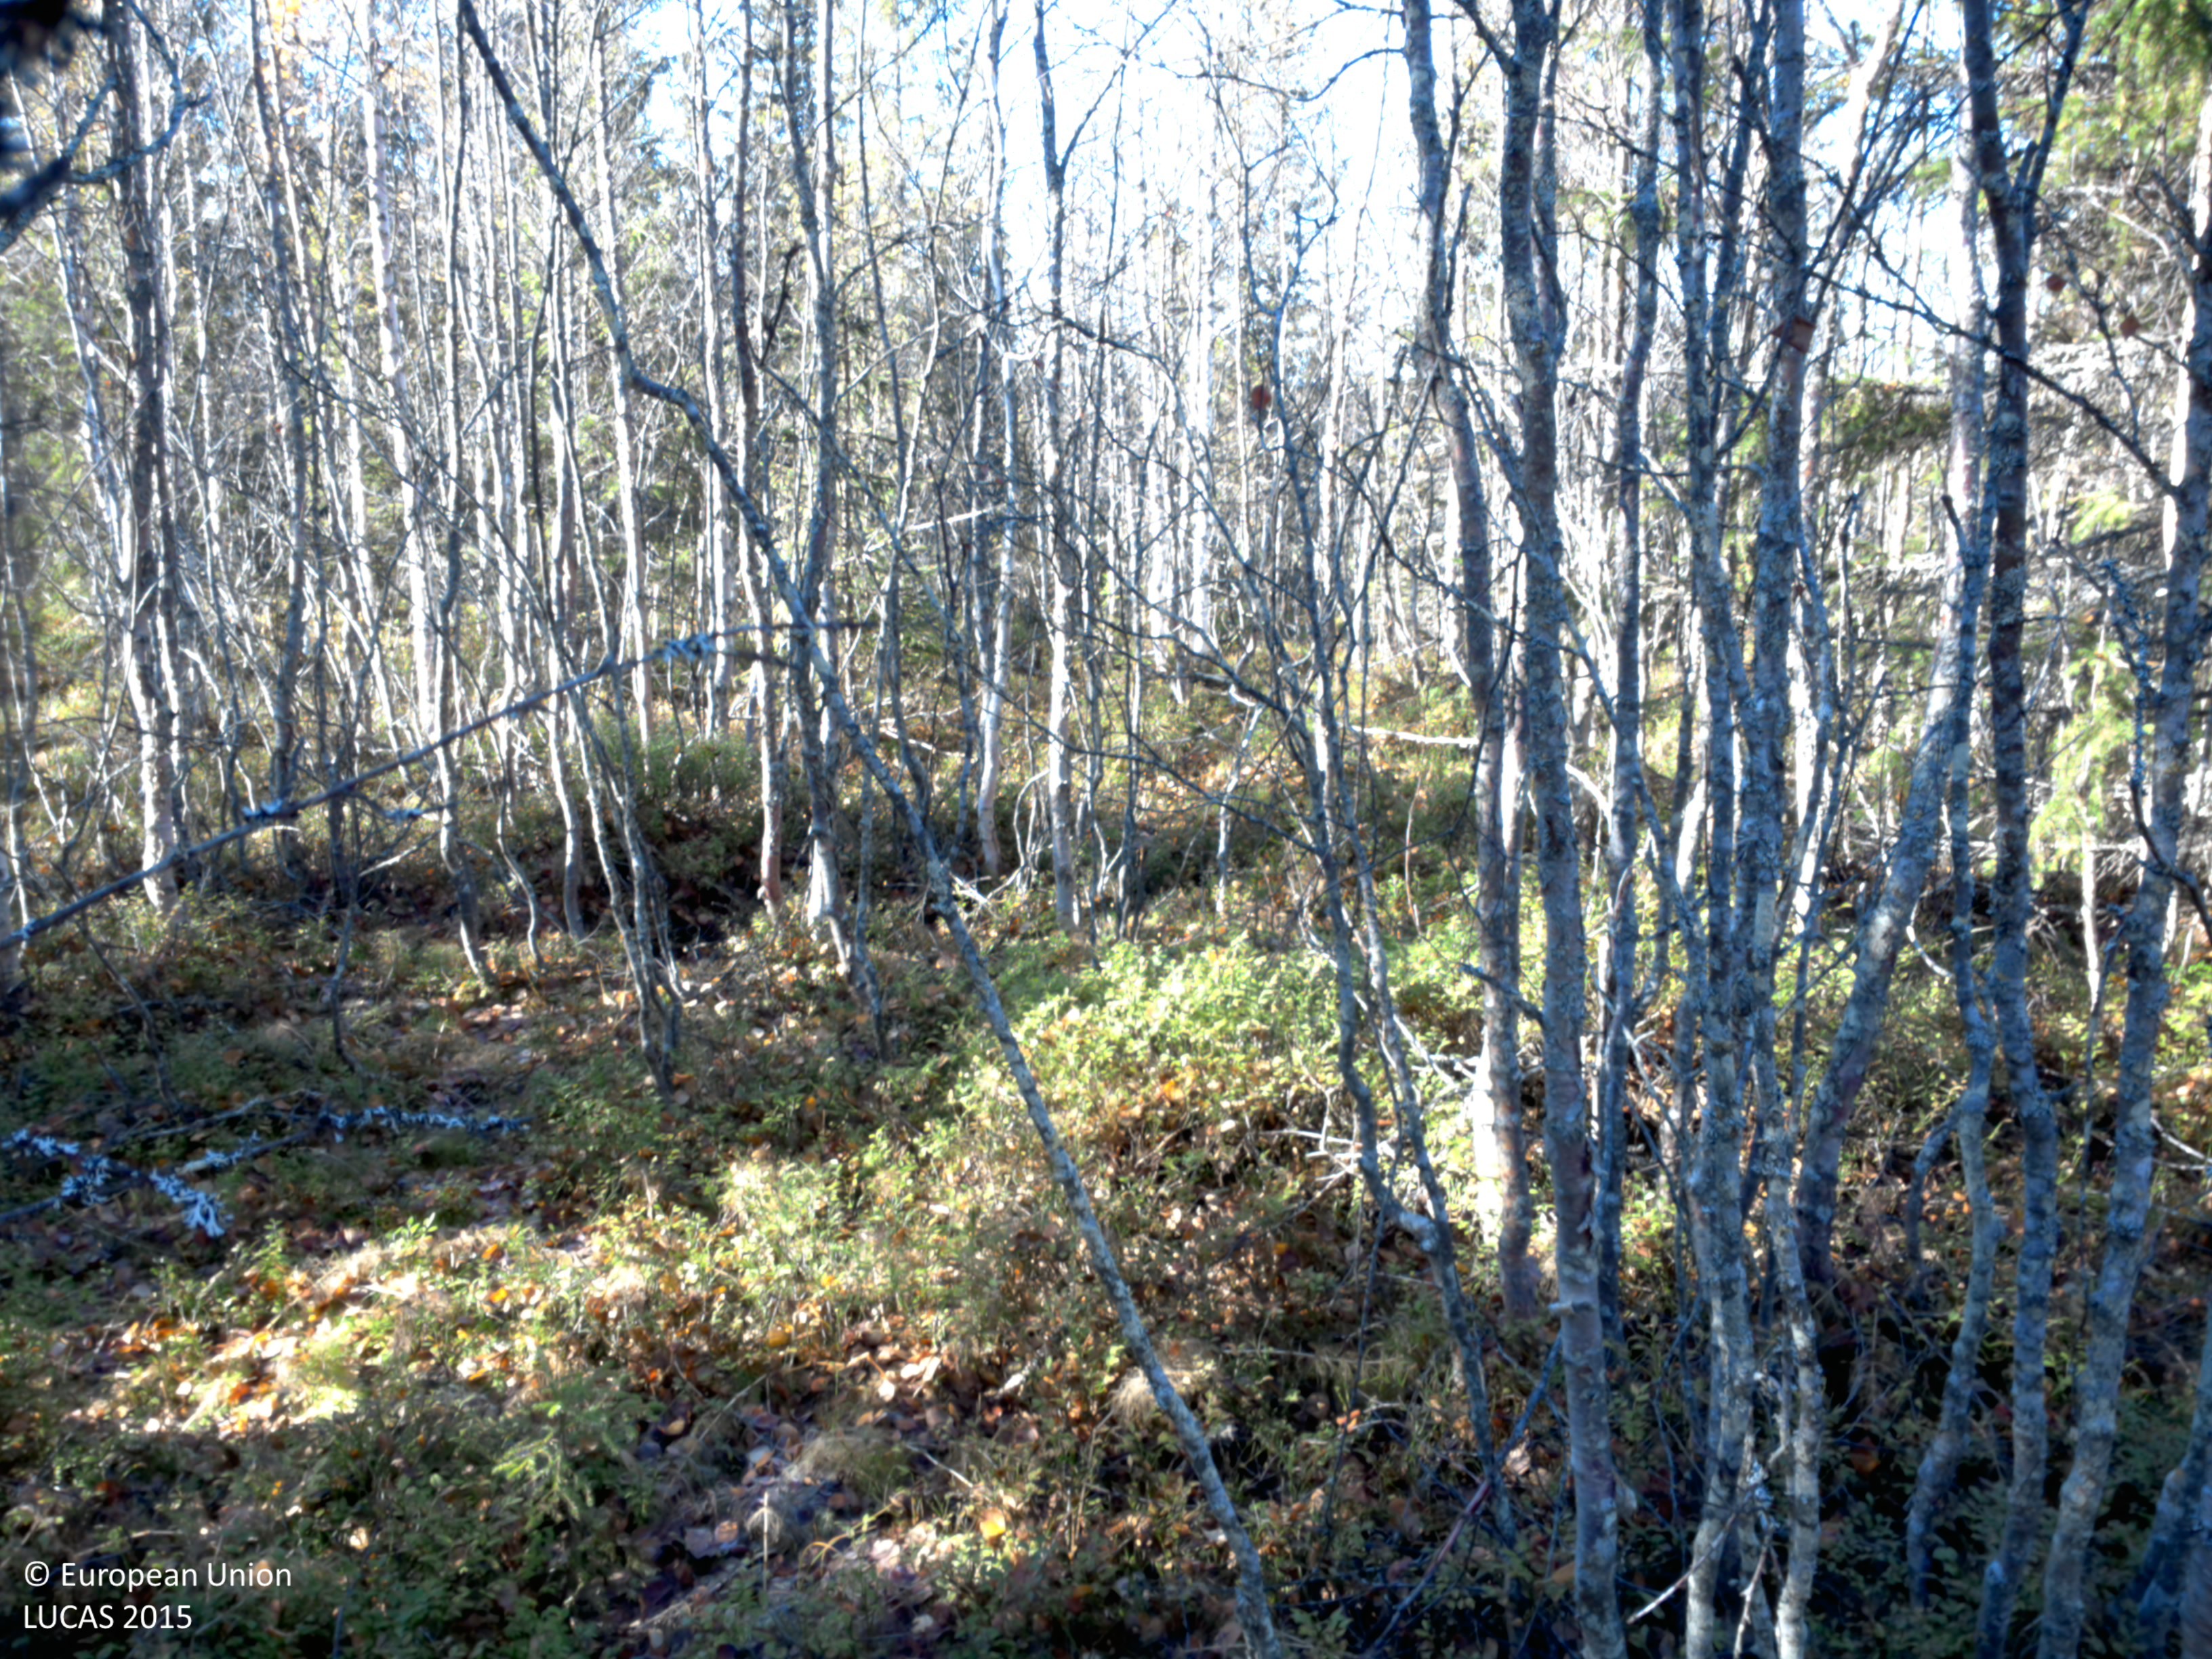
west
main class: Woodland
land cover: Spruce dominated mixed woodland
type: boreal forest
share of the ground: > 75 %
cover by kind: broadleaved forest trees 50 %, coniferous forest trees 30 %, shrubs 10 %, herbaceous plants 5 %, lichens and mosses 5 %
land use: Forestry
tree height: > 5 m
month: October
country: SE
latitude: 64.6076
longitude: 17.7625
